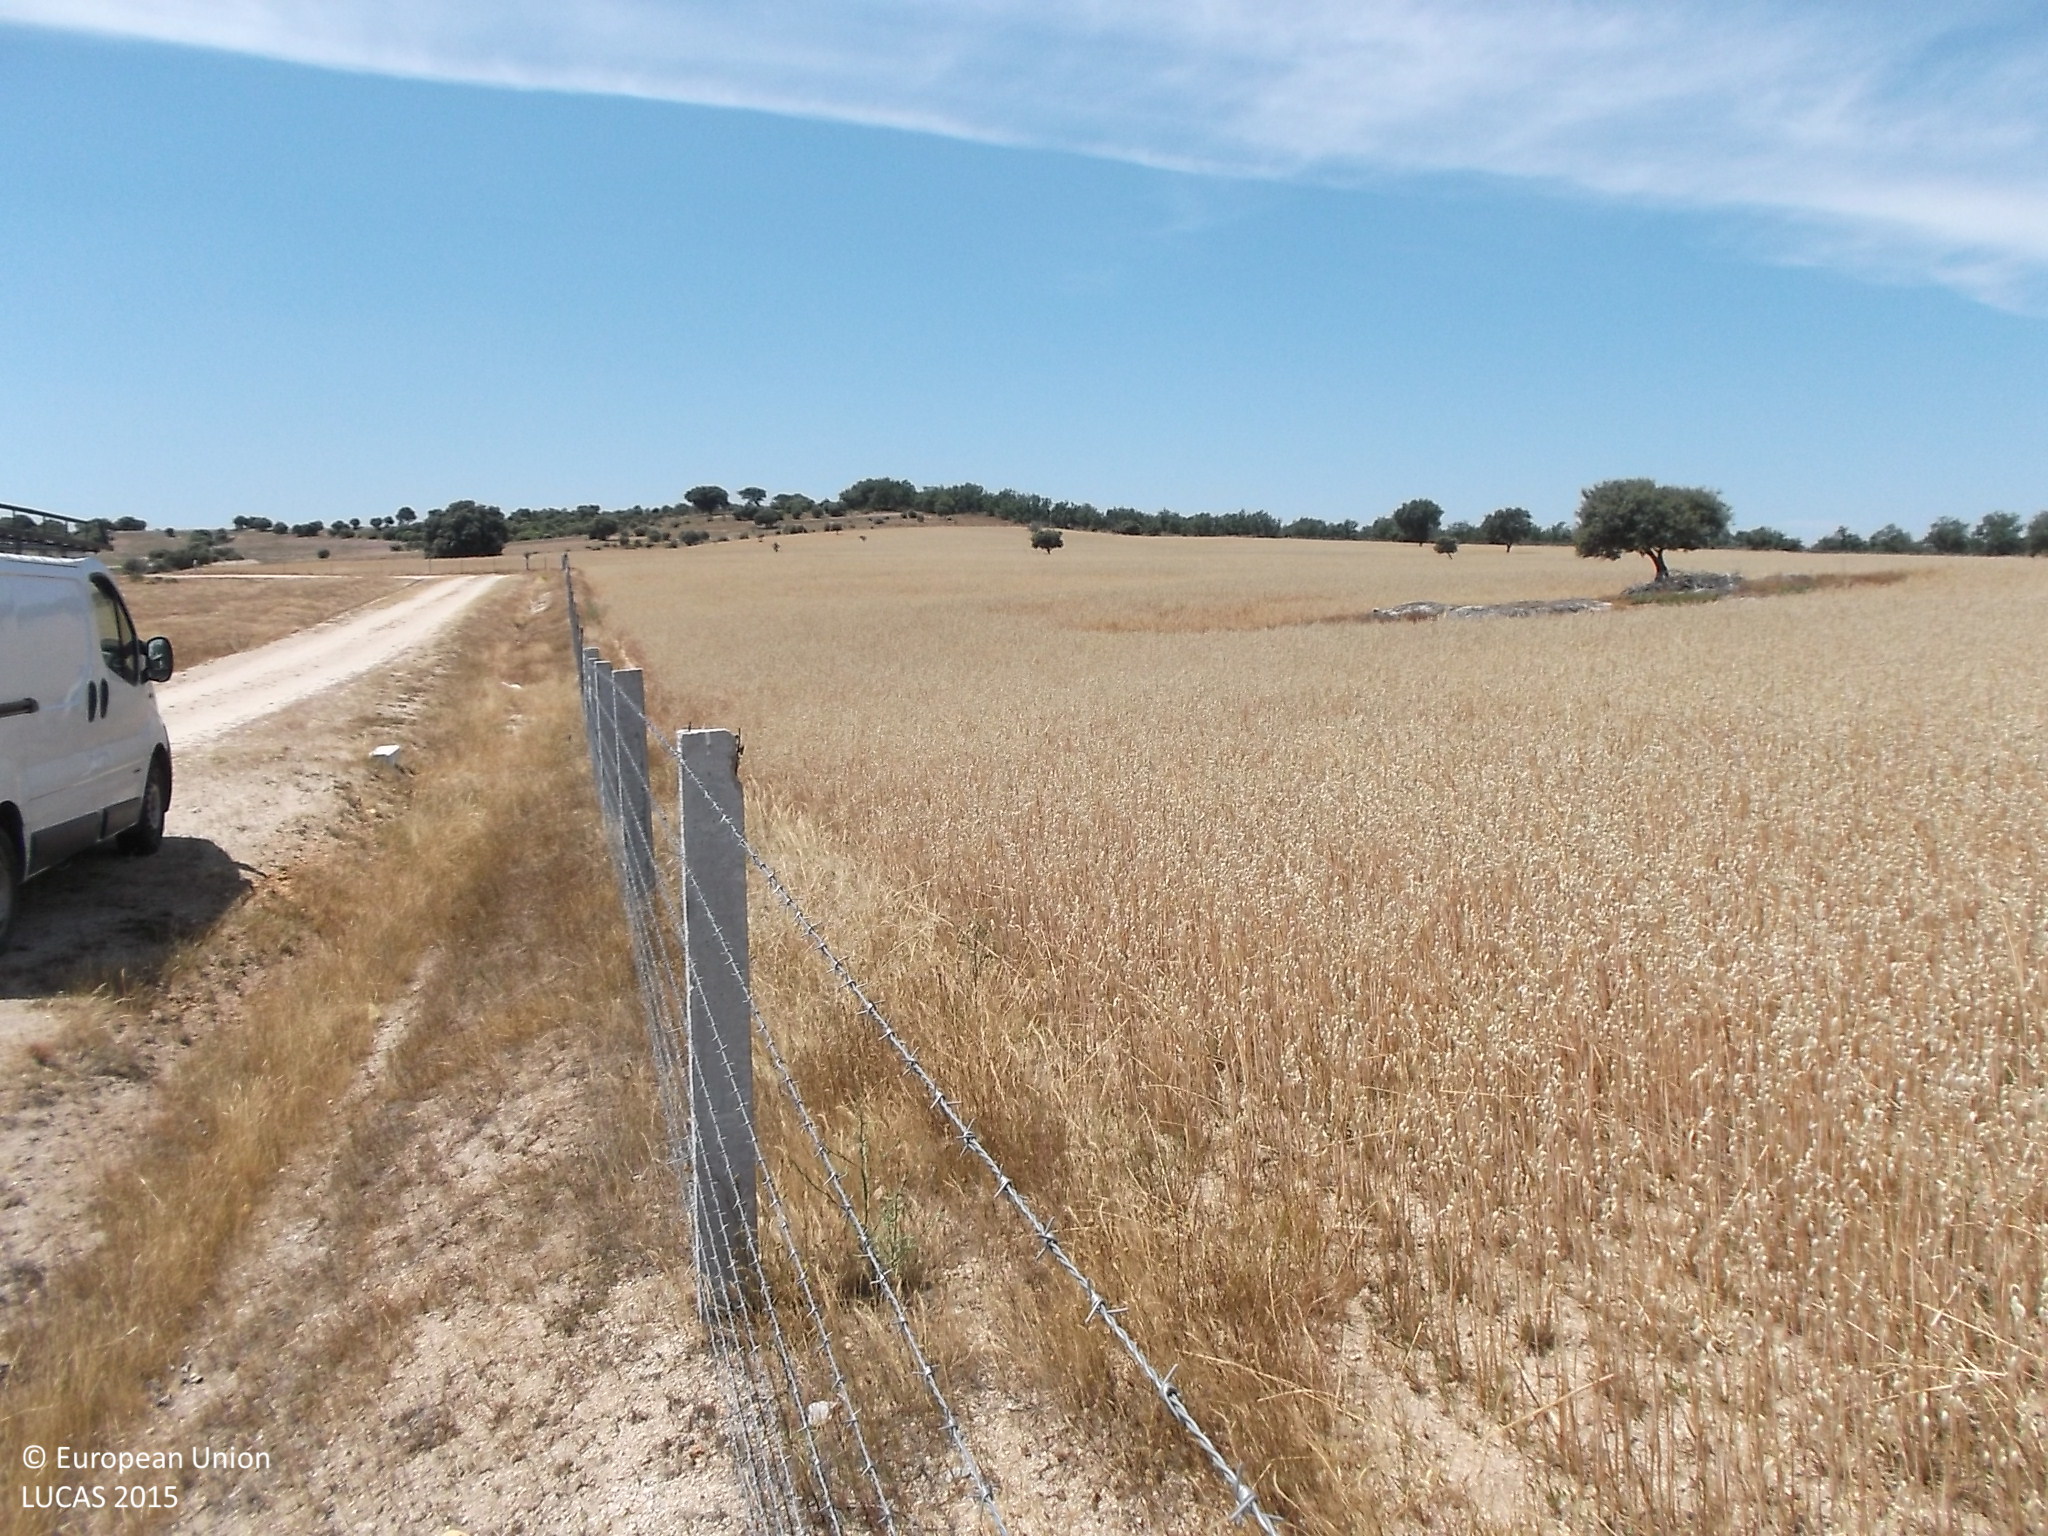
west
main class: Cropland
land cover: Oats
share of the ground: > 75 %
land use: Agriculture (excluding fallow land and kitchen gardens)
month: June
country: ES
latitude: 41.2900
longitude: -6.0550
